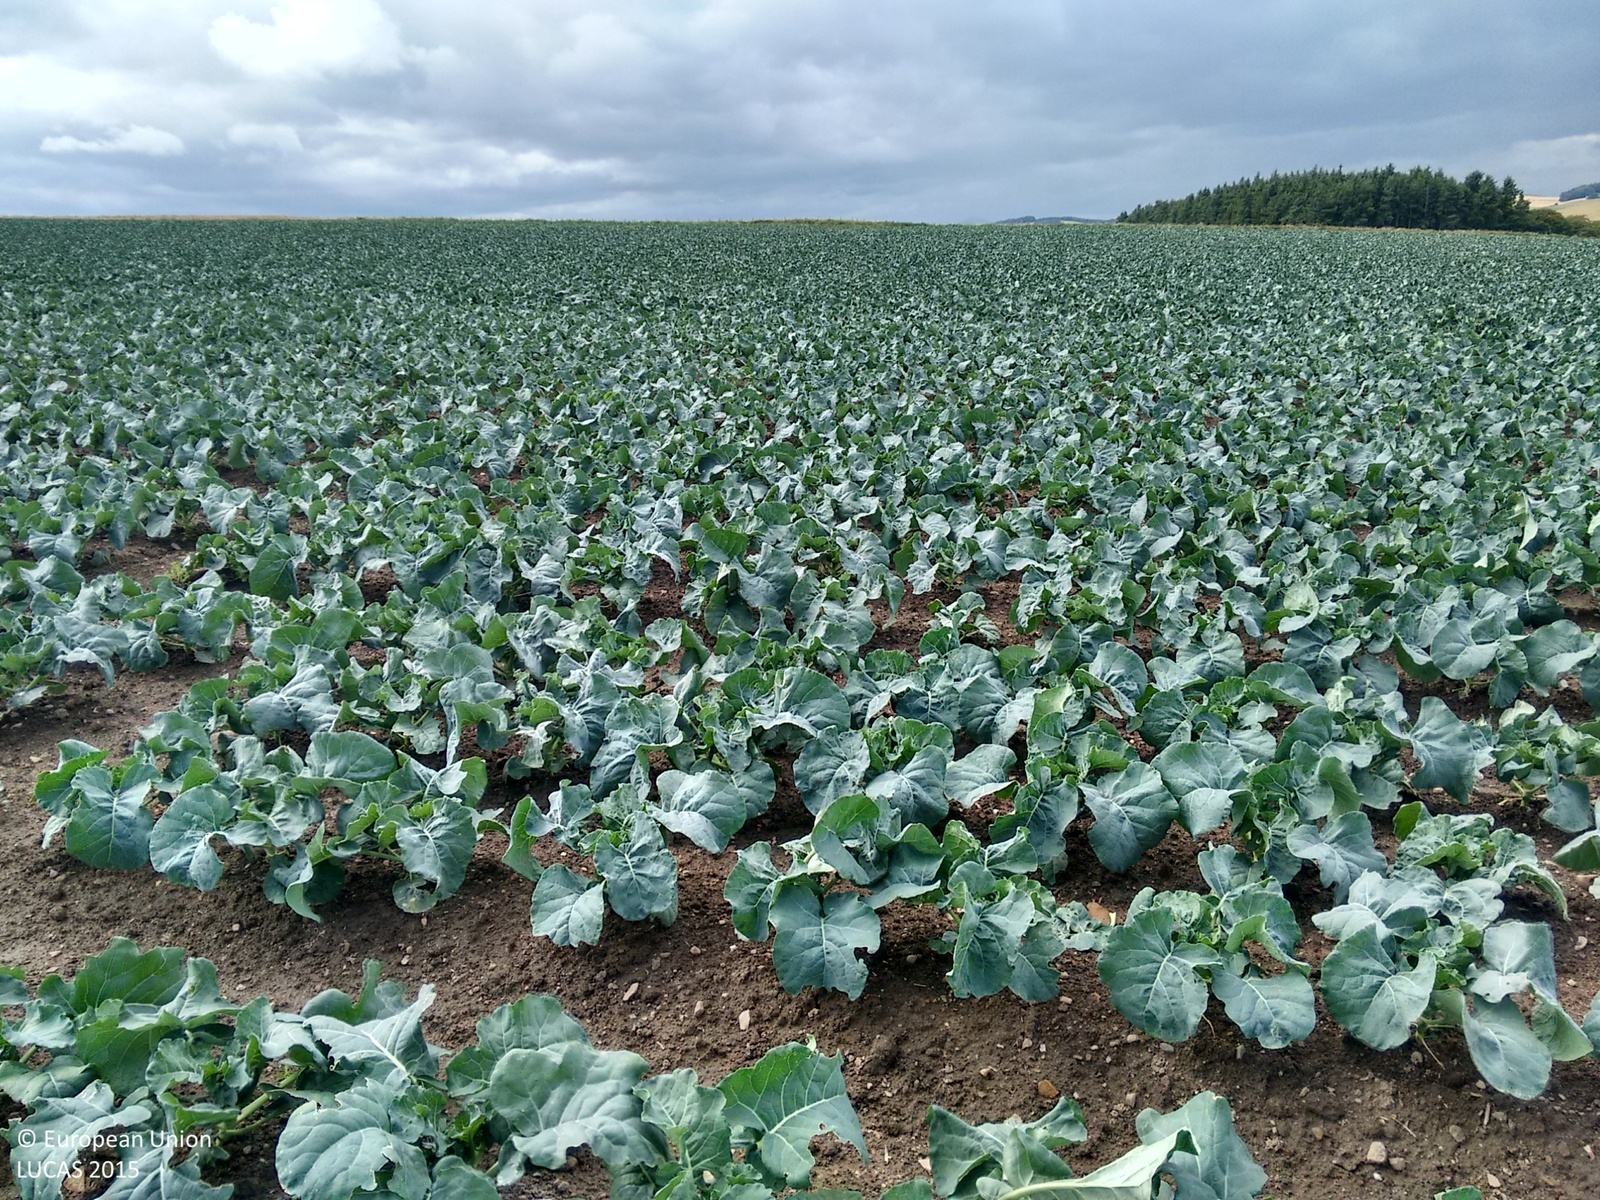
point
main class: Cropland
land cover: Other fresh vegetables
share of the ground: > 75 %
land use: Agriculture (excluding fallow land and kitchen gardens)
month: August
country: GB
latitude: 56.2946
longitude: -2.9436
